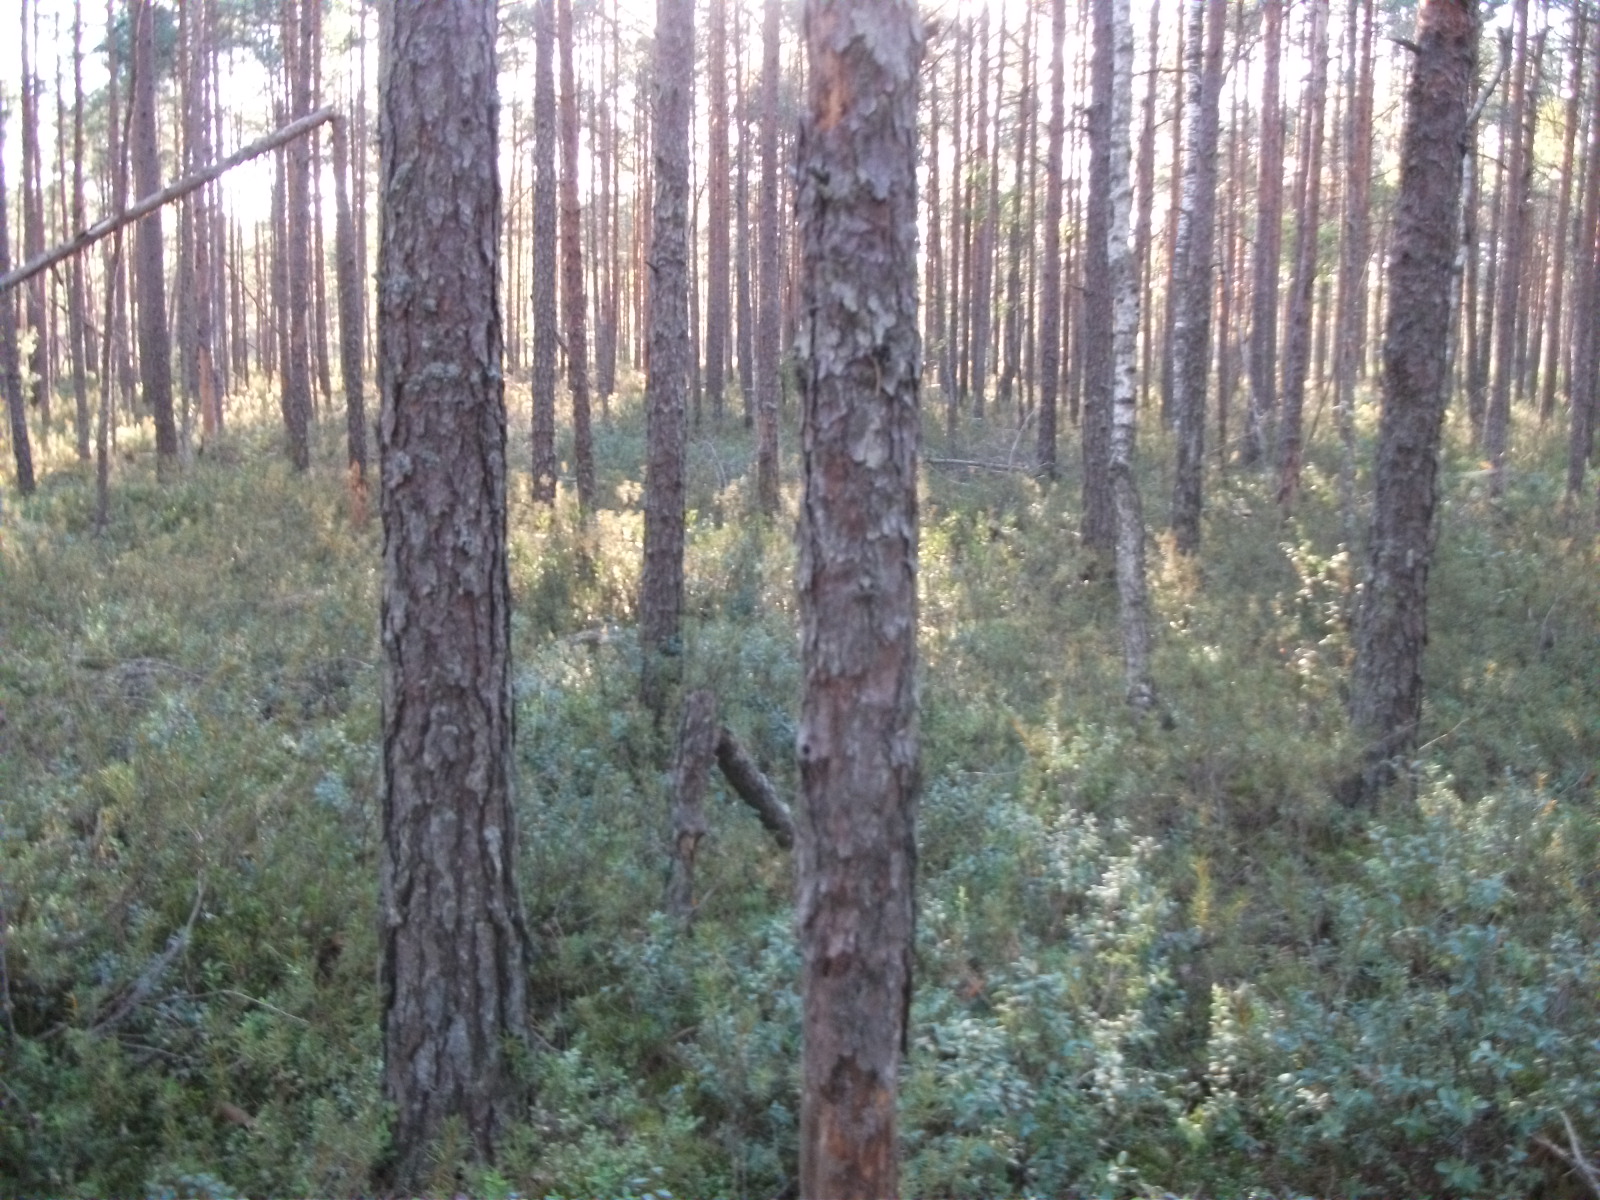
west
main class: Woodland
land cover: Pine dominated coniferous woodland
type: hemiboreal forest and nemoral coniferous forest and mixed broadleaved-coniferous forest
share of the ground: > 75 %
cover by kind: coniferous forest trees 85 %, lichens and mosses 15 %
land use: Forestry
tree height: > 5 m
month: August
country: LV
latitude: 56.5222
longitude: 26.3829
